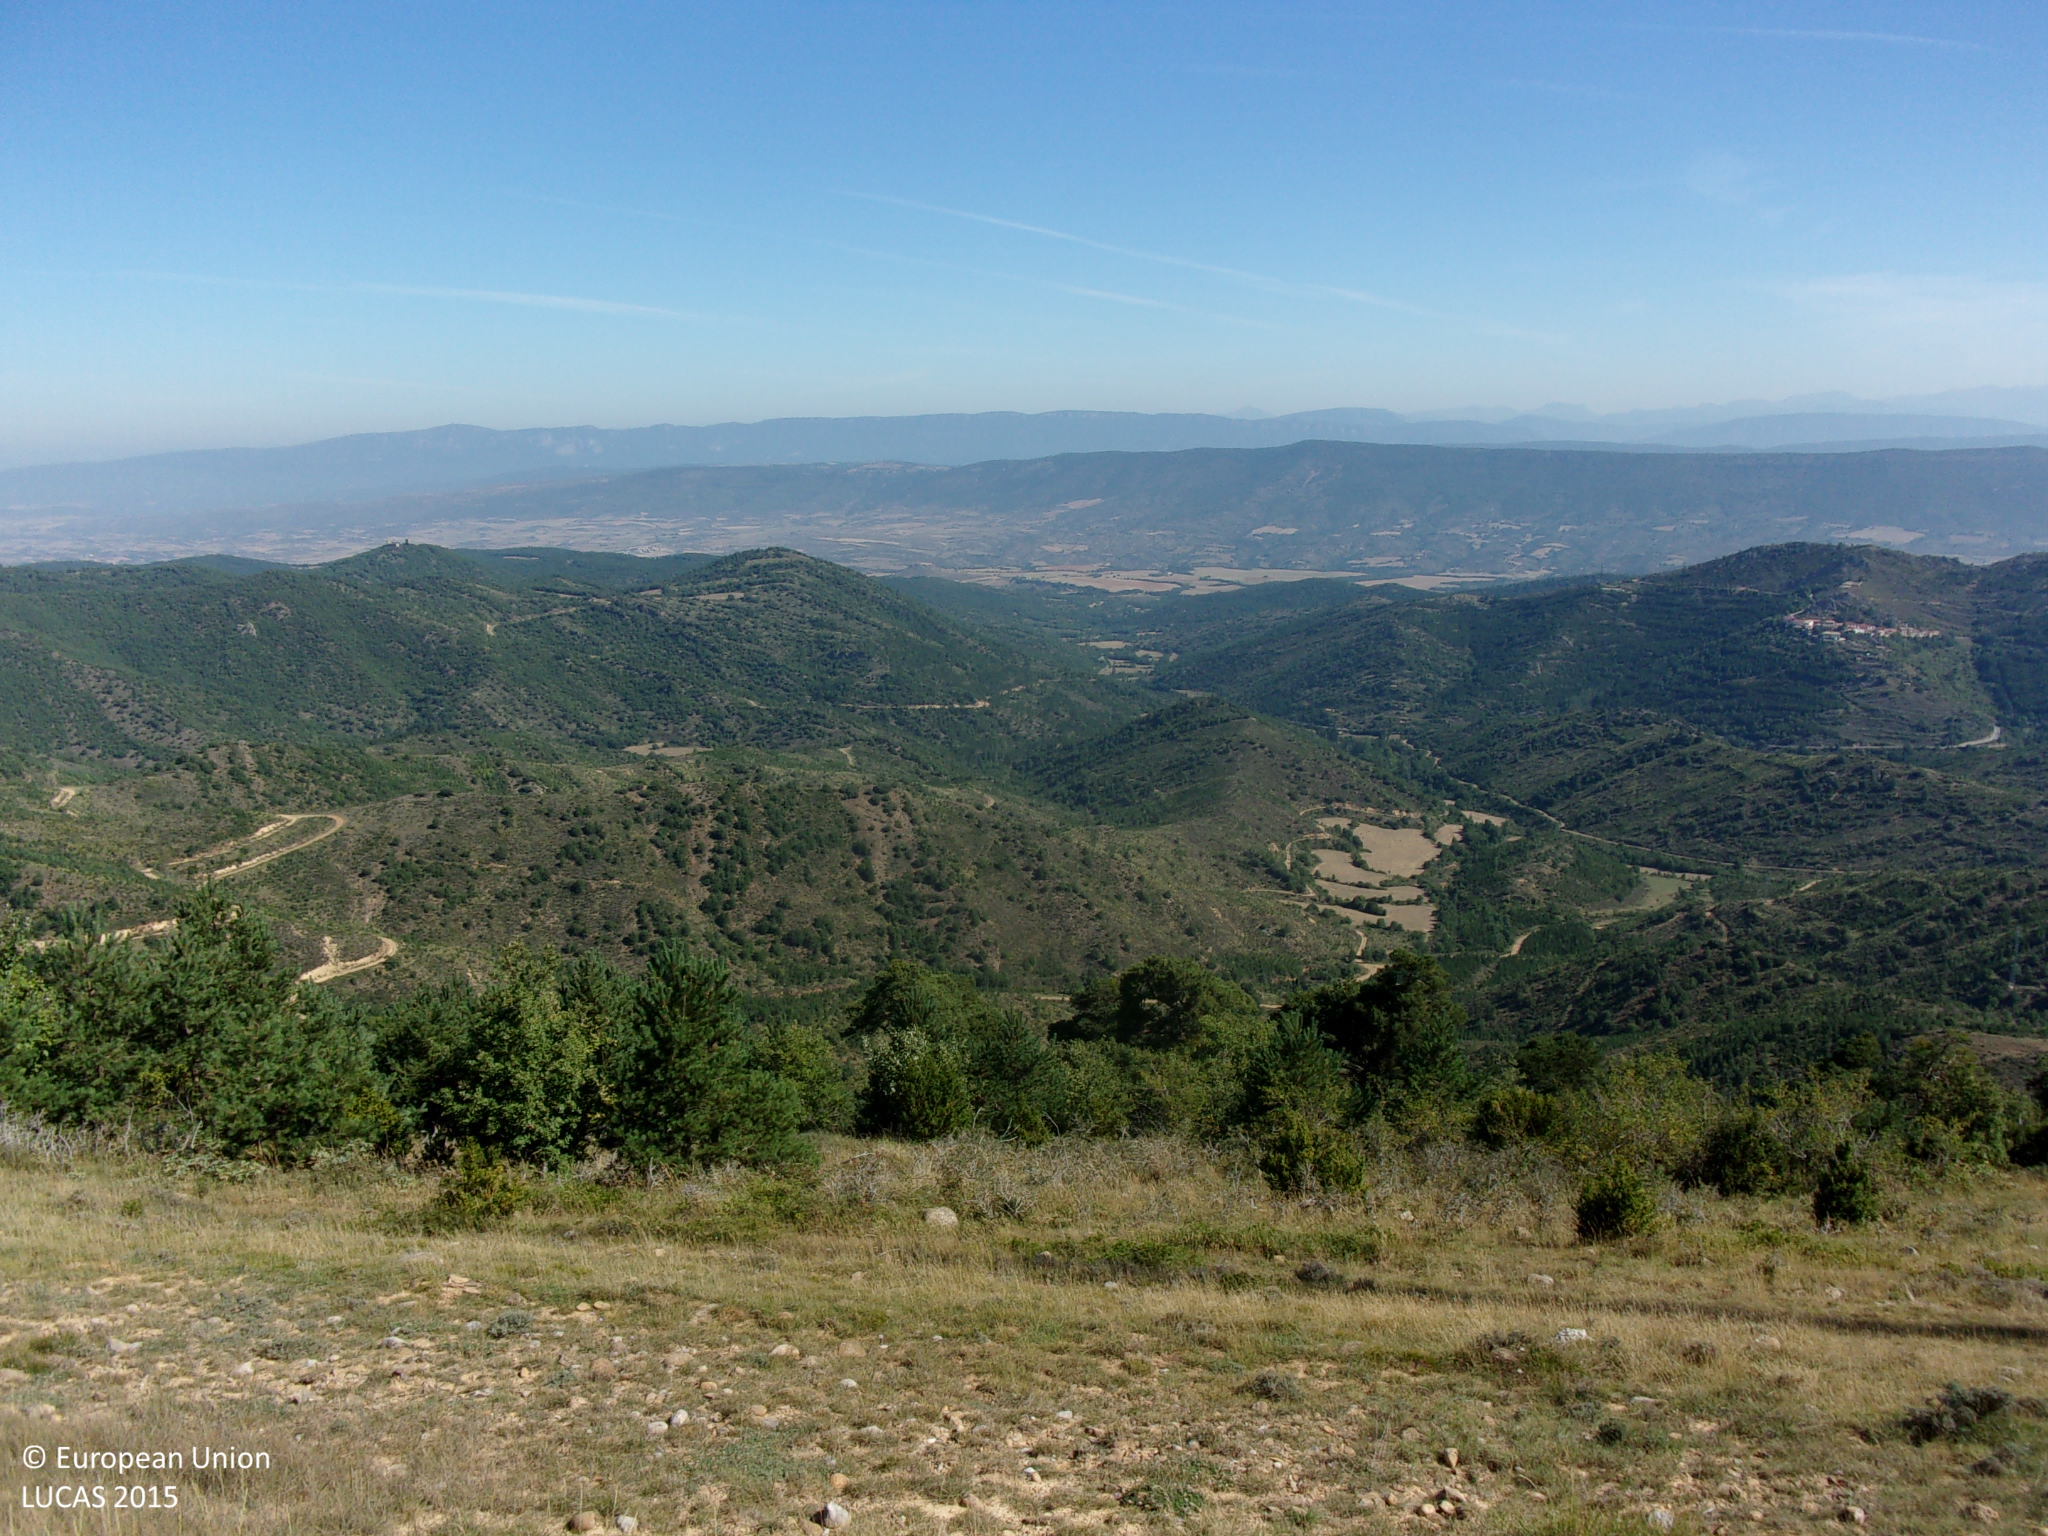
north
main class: Woodland
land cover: Pine dominated coniferous woodland
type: coniferous forest of the mediterranean region
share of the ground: > 75 %
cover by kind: coniferous forest trees 100 %
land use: Forestry
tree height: > 5 m
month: August
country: ES
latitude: 42.4420
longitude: -1.1060
